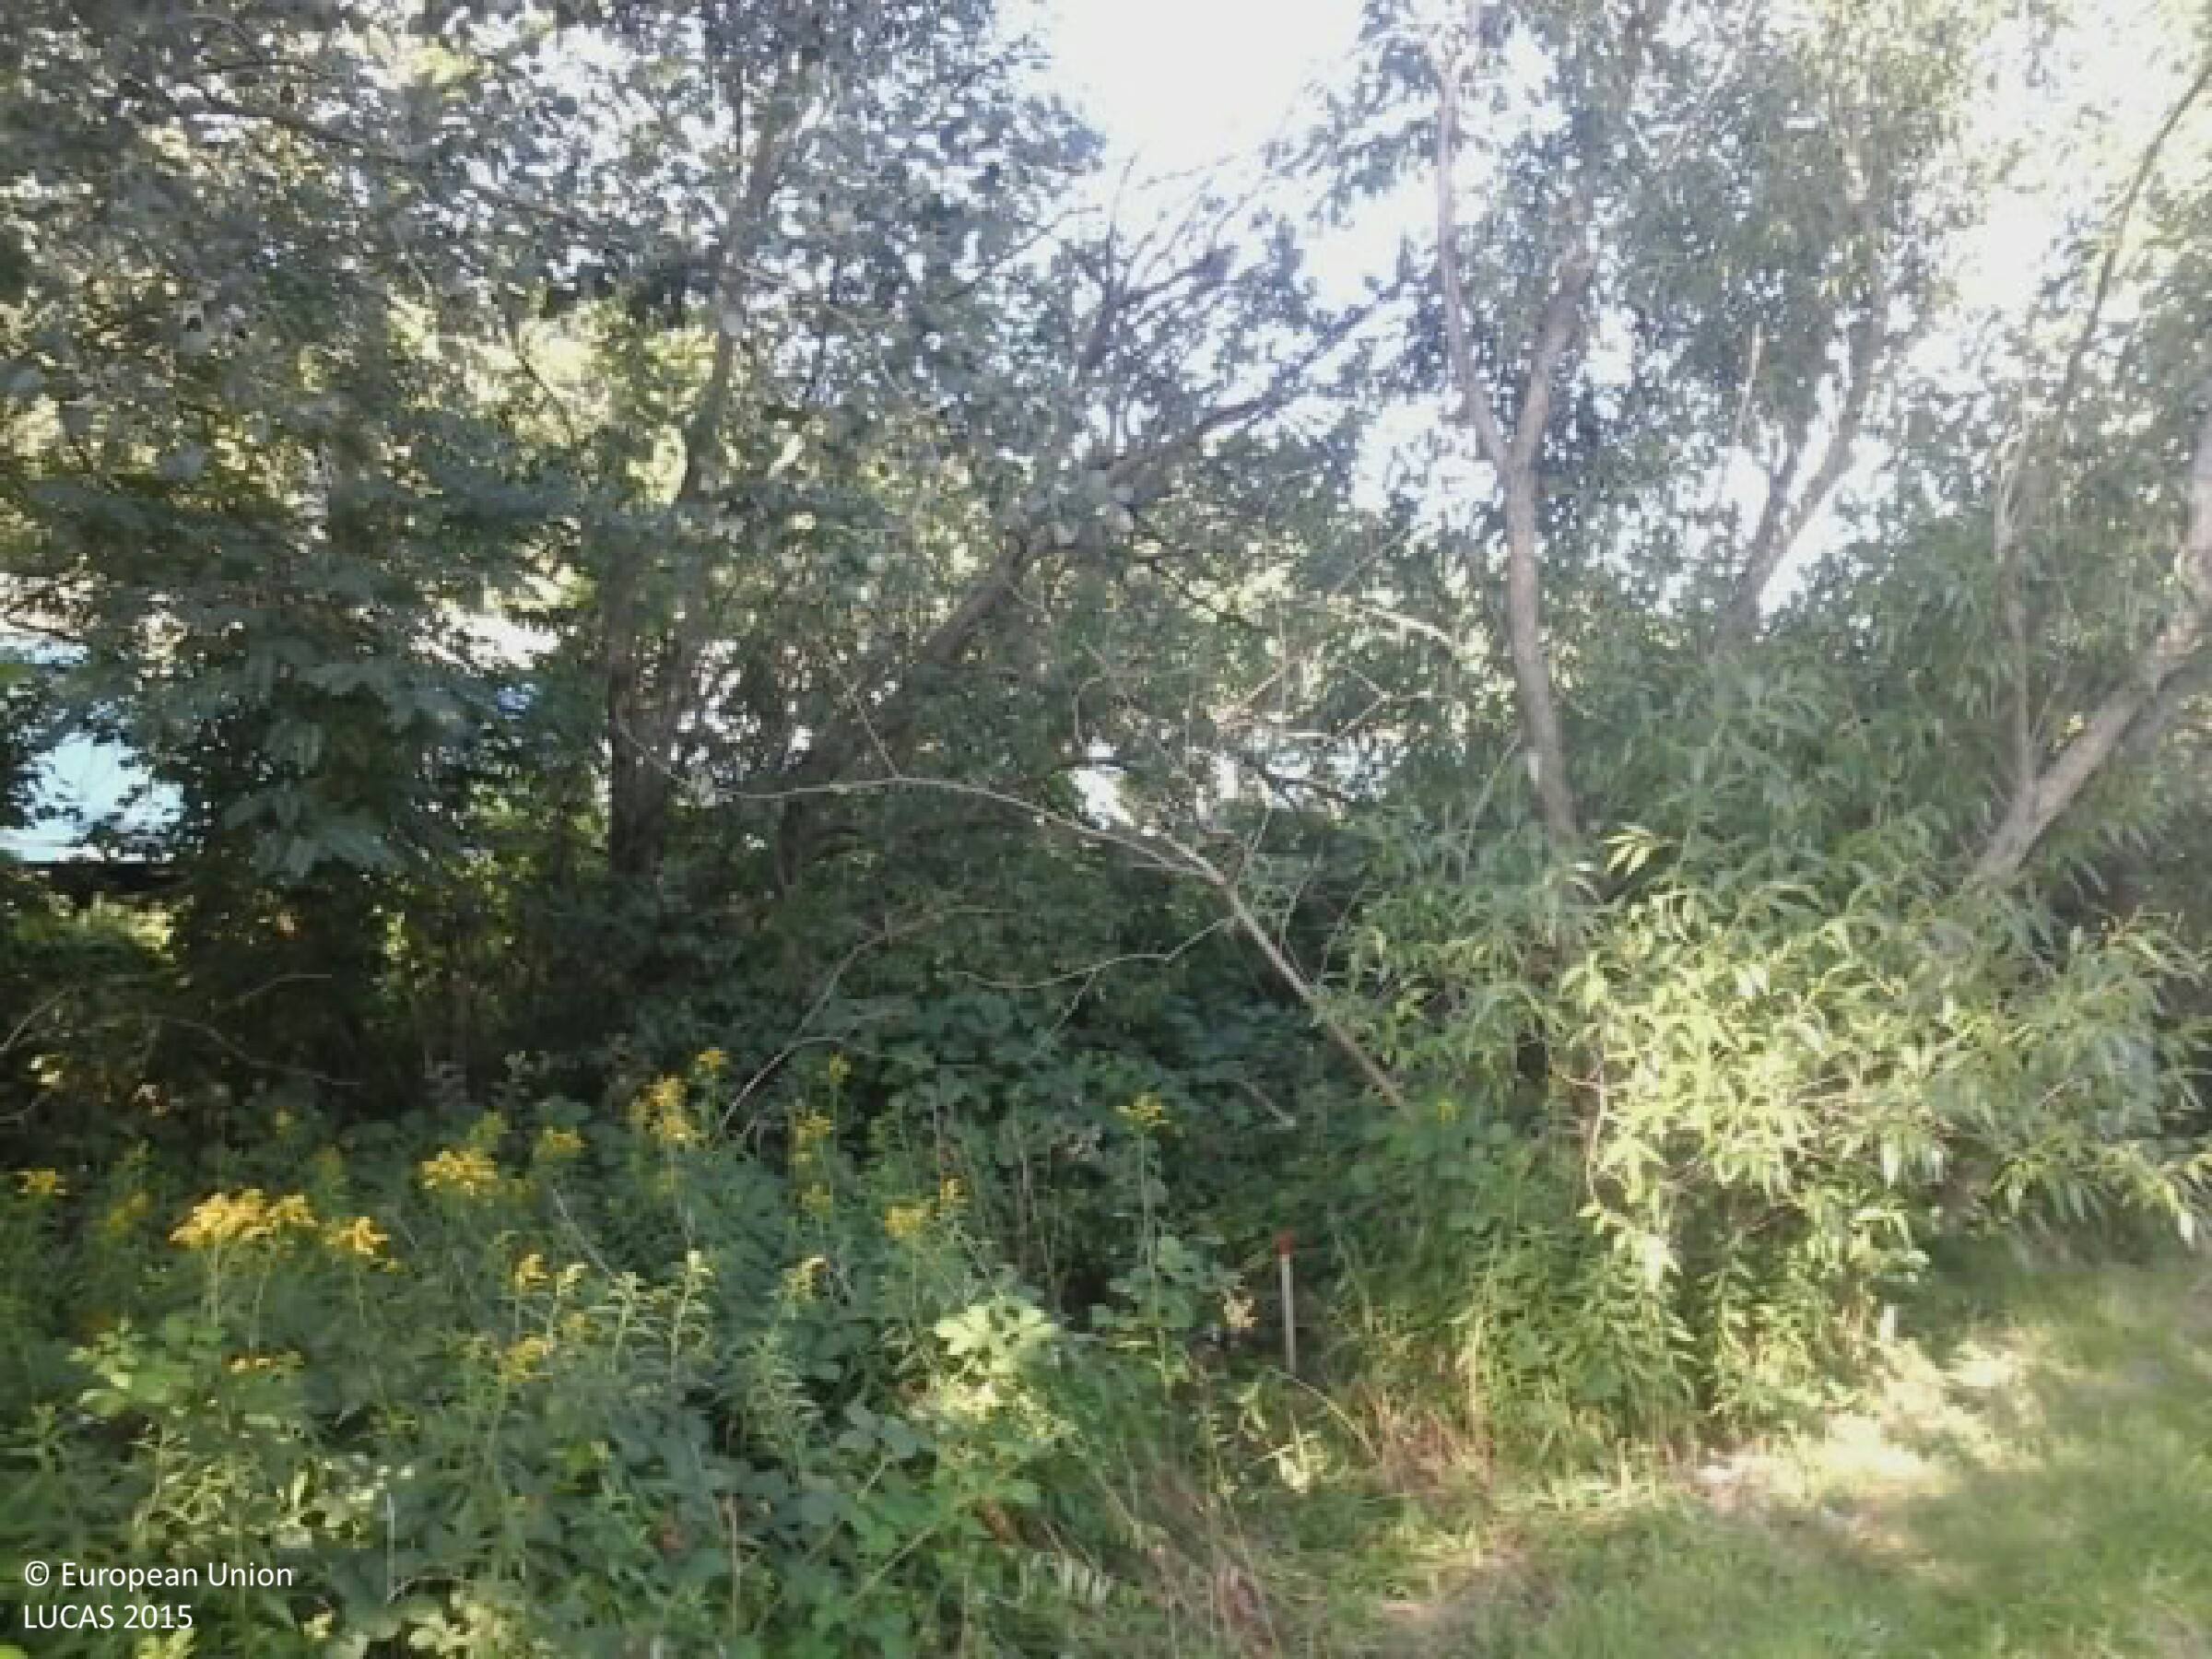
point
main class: Woodland
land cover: Broadleaved woodland
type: mesophytic deciduous forest
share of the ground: > 75 %
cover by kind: broadleaved forest trees 75 %, shrubs 15 %, herbaceous plants 10 %
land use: Semi-natural and natural areas not in use
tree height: > 5 m
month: August
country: HU
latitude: 46.7133
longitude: 17.3436
